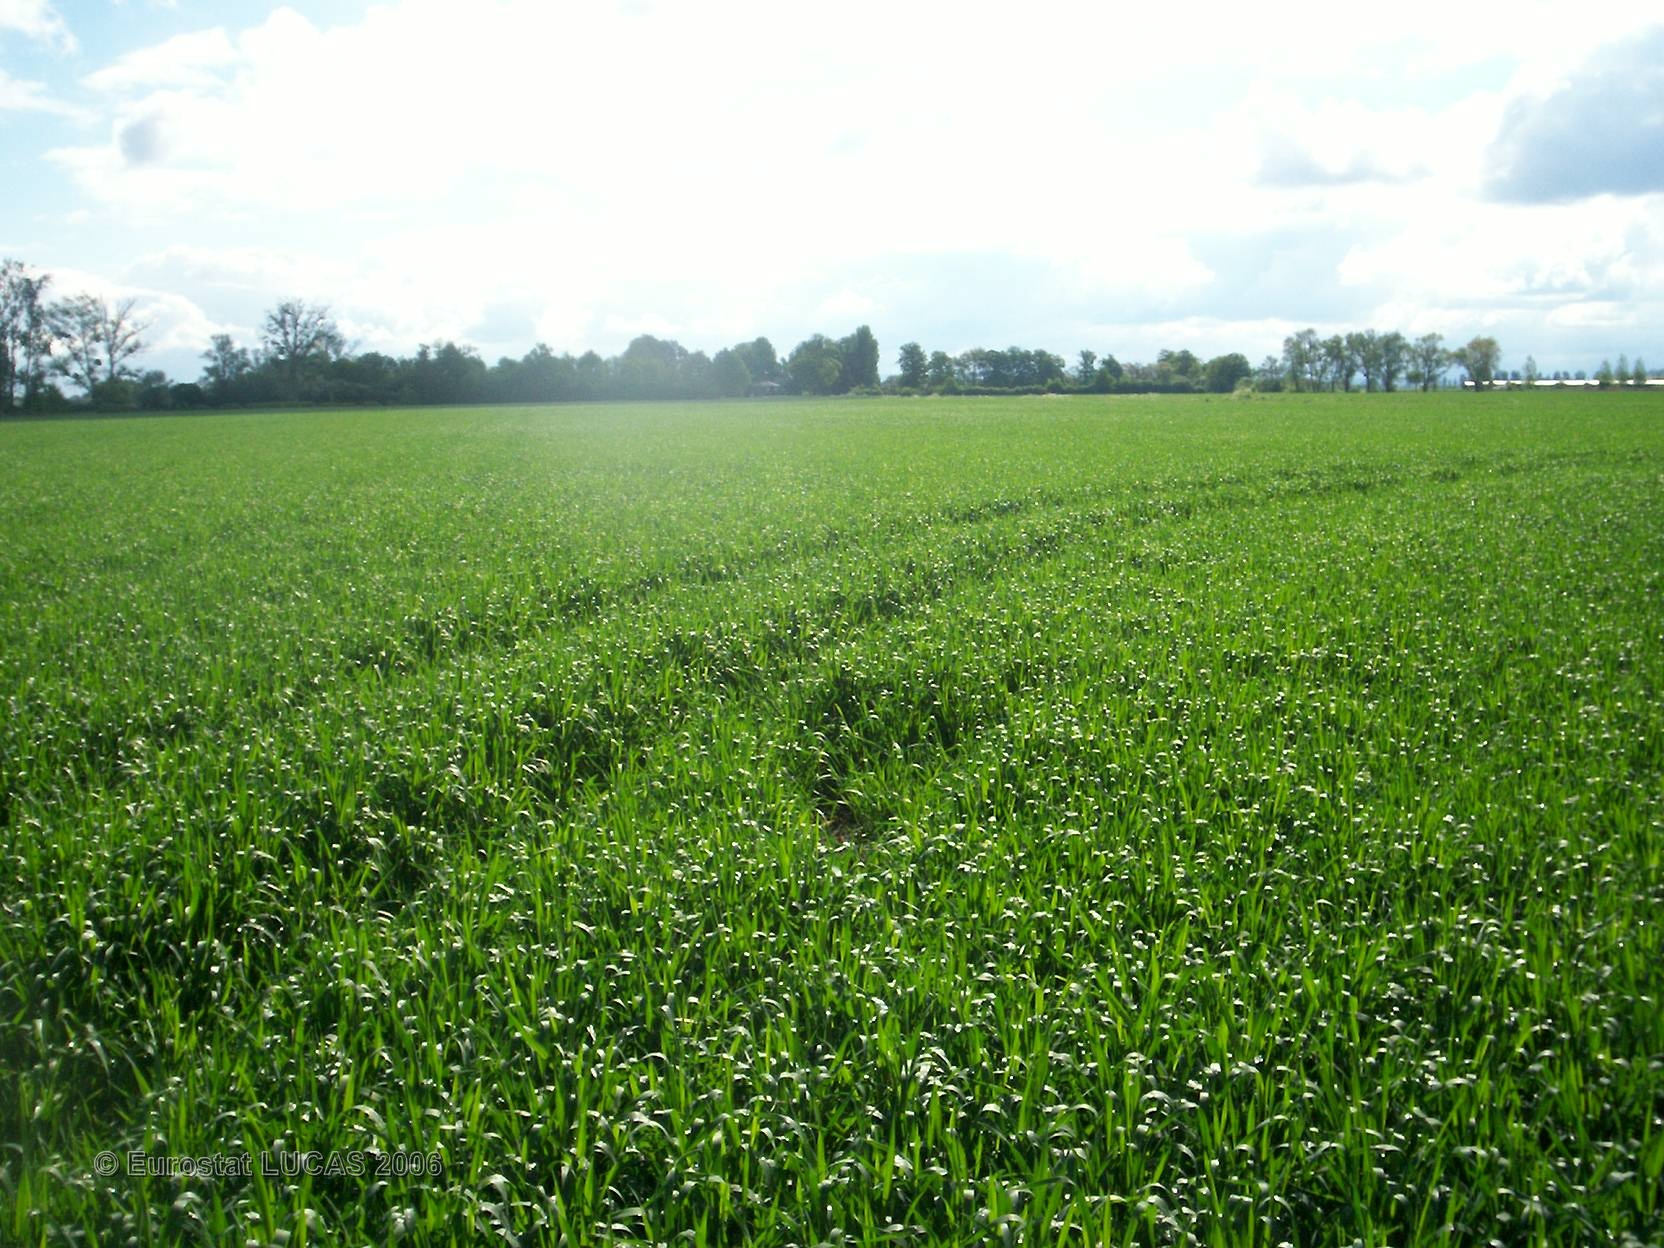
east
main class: Cropland
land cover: Common wheat
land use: Agriculture (excluding fallow land and kitchen gardens)
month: May
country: FR
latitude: 45.8986
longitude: 3.1814
